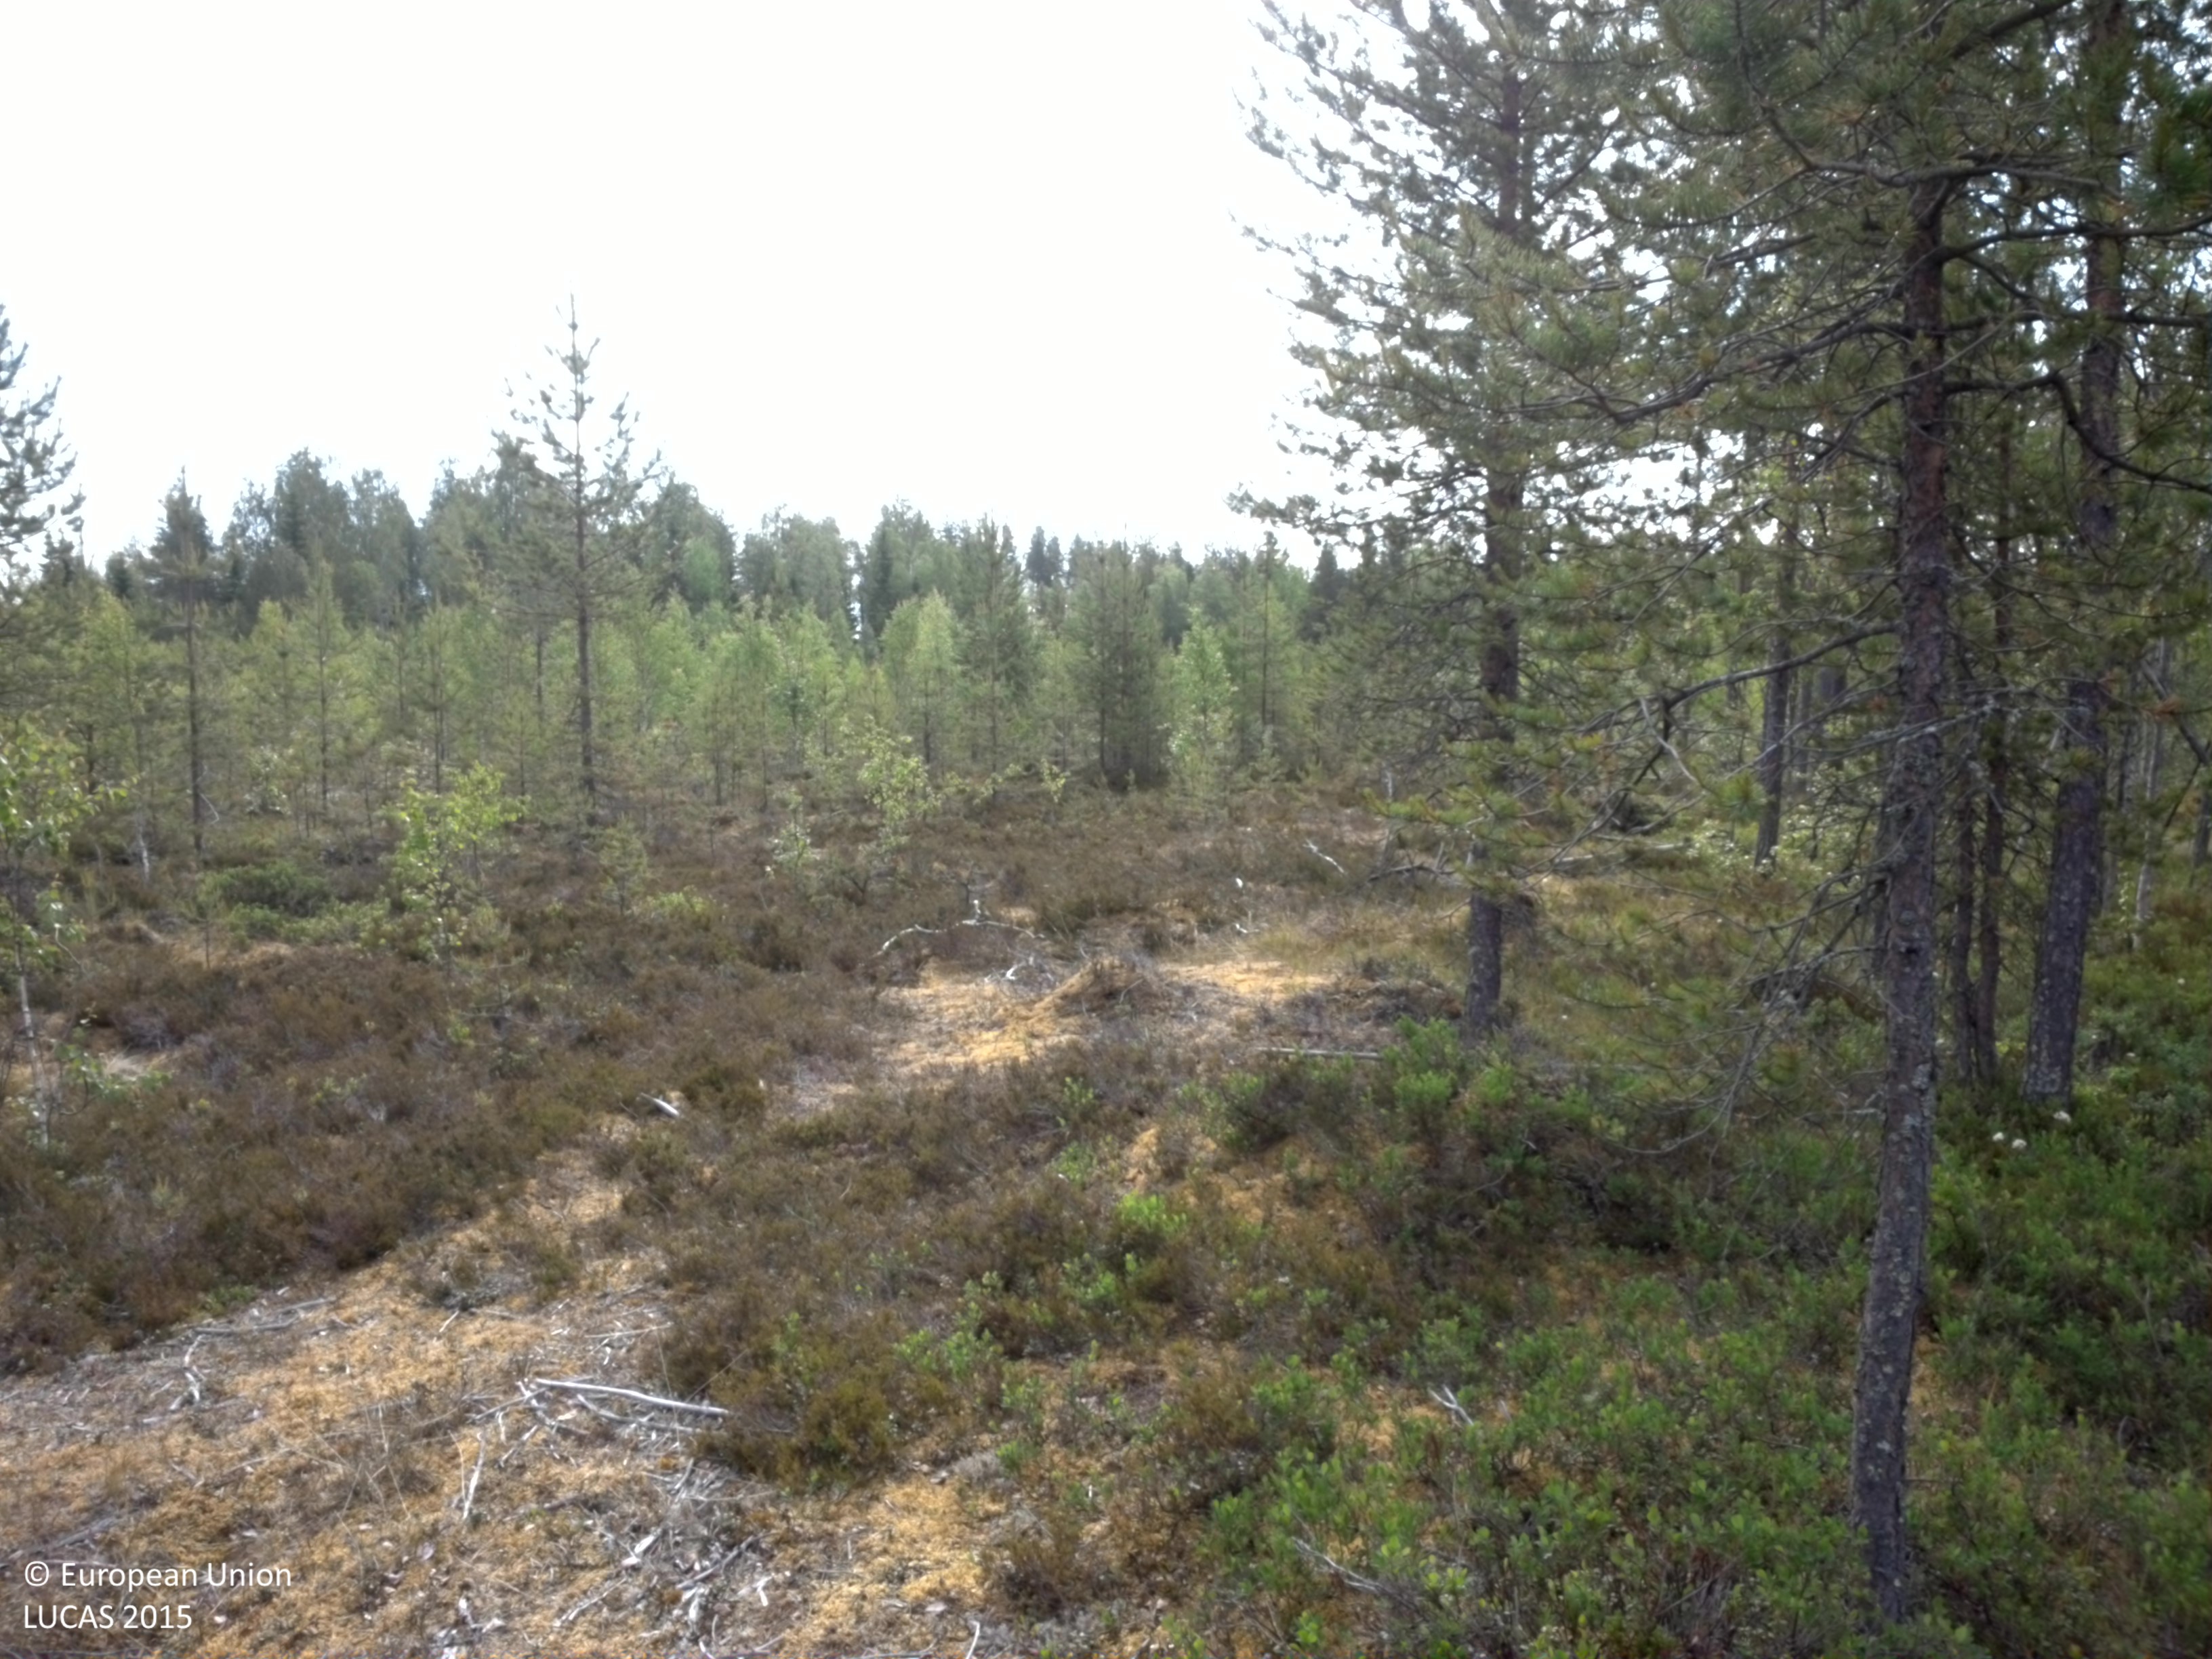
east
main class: Woodland
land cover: Pine dominated mixed woodland
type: boreal forest
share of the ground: 25 - 50 %
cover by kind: shrubs 40 %, coniferous forest trees 30 %, lichens and mosses 20 %, broadleaved forest trees 10 %
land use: Forestry
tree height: < 5 m
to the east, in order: Pine dominated mixed woodland; Spruce dominated mixed woodland; Pine dominated coniferous woodland
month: July
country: SE
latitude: 64.5018
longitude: 20.8266
